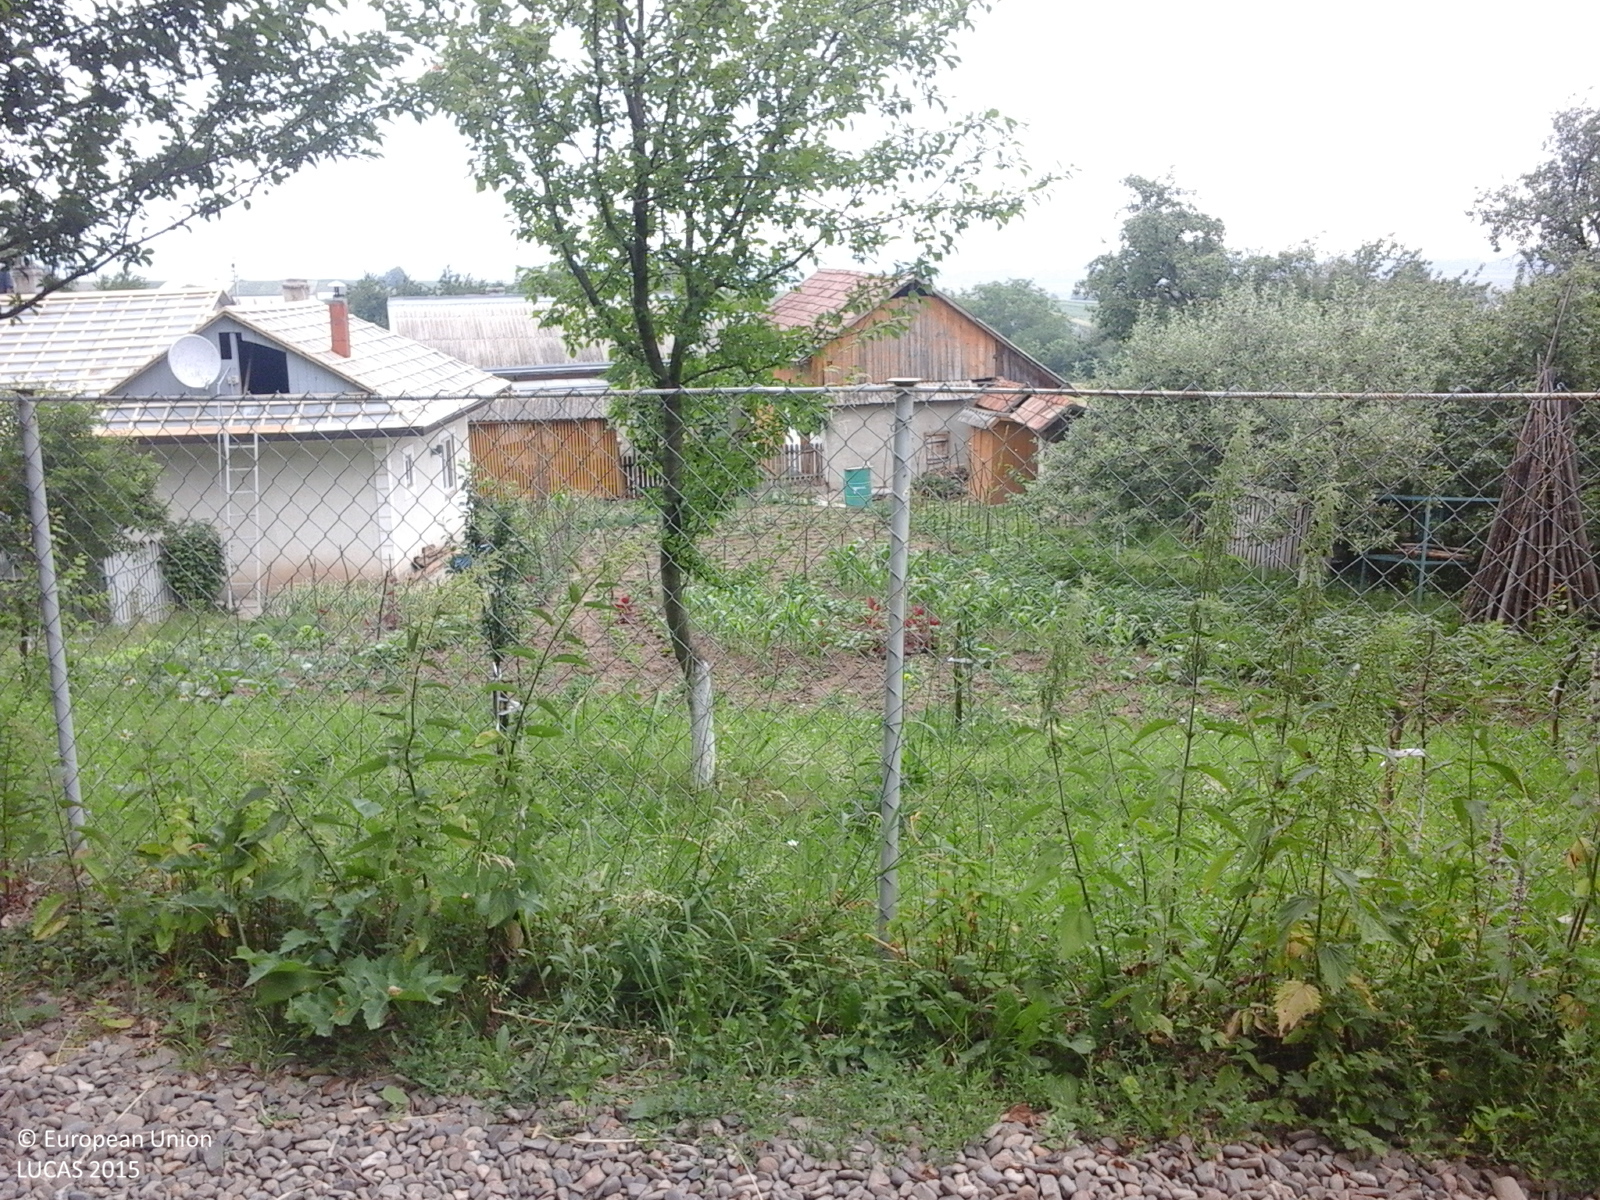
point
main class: Cropland
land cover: Apple fruit
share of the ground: 10 - 25 %
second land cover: Grassland without tree/shrub cover
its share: > 75 %
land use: Agriculture (excluding fallow land and kitchen gardens)
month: June
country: RO
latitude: 47.5721
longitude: 26.3975
